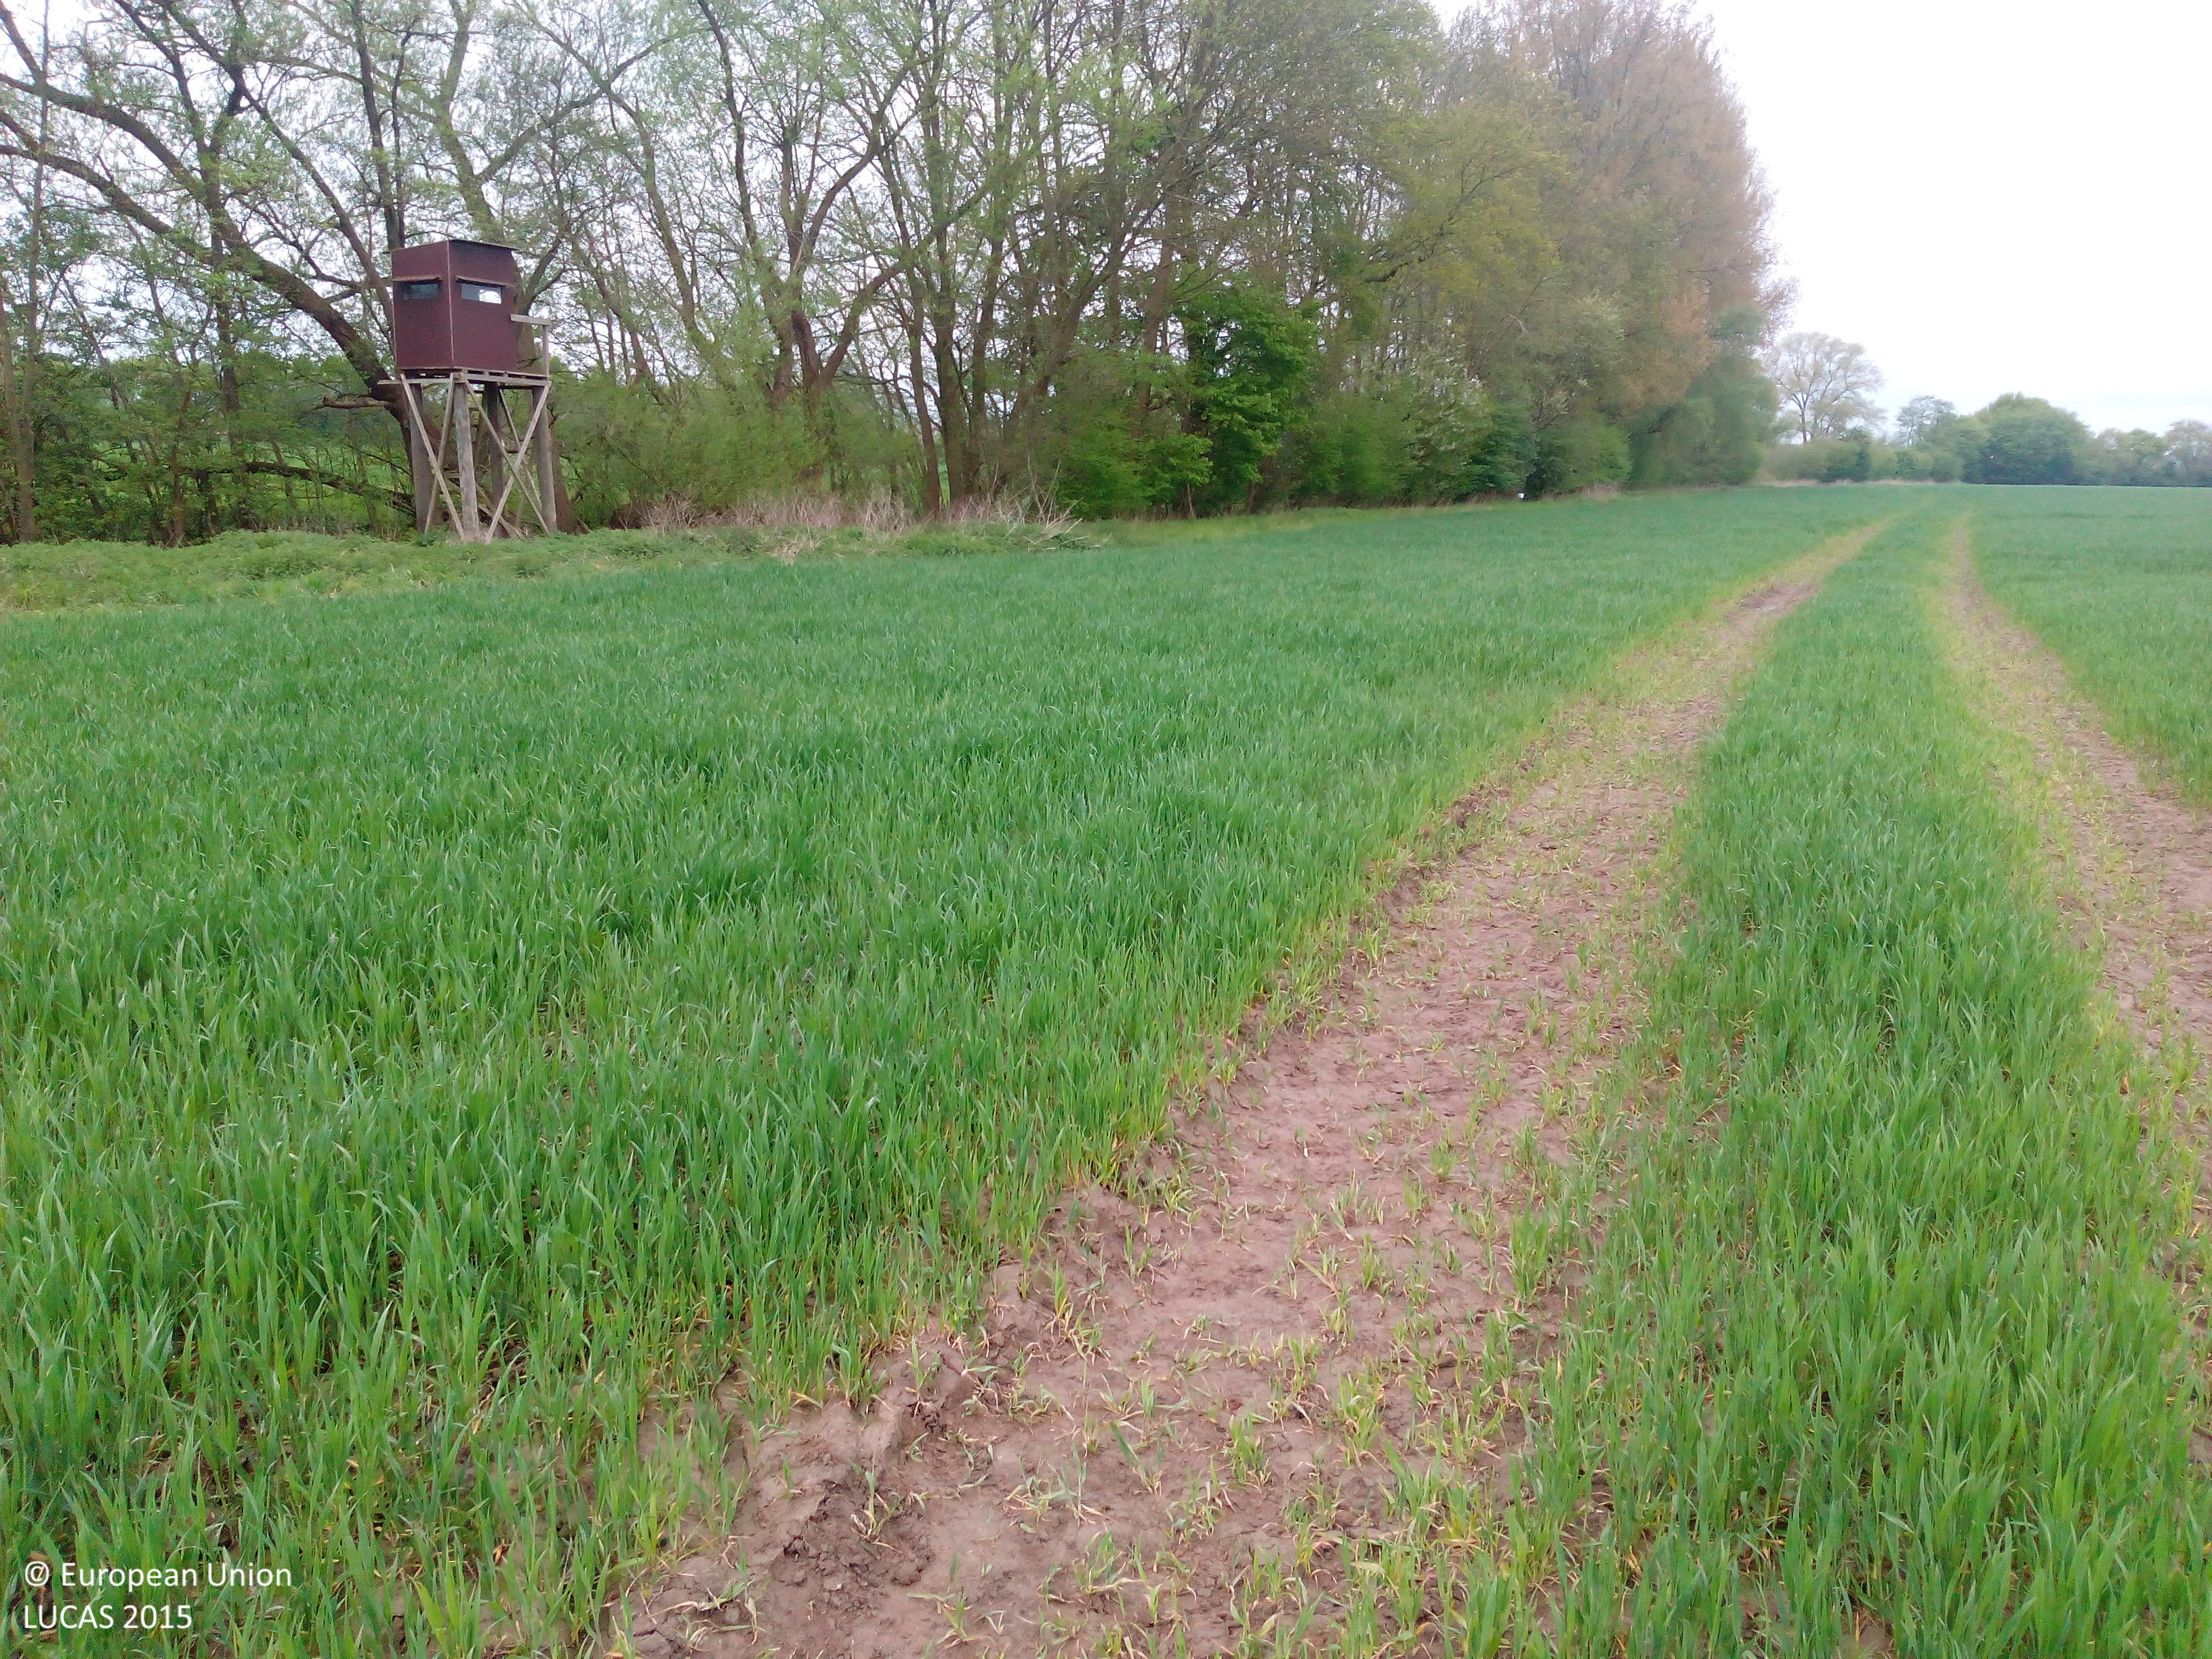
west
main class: Cropland
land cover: Common wheat
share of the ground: > 75 %
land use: Agriculture (excluding fallow land and kitchen gardens)
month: May
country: DE
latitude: 51.9174
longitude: 7.3978
